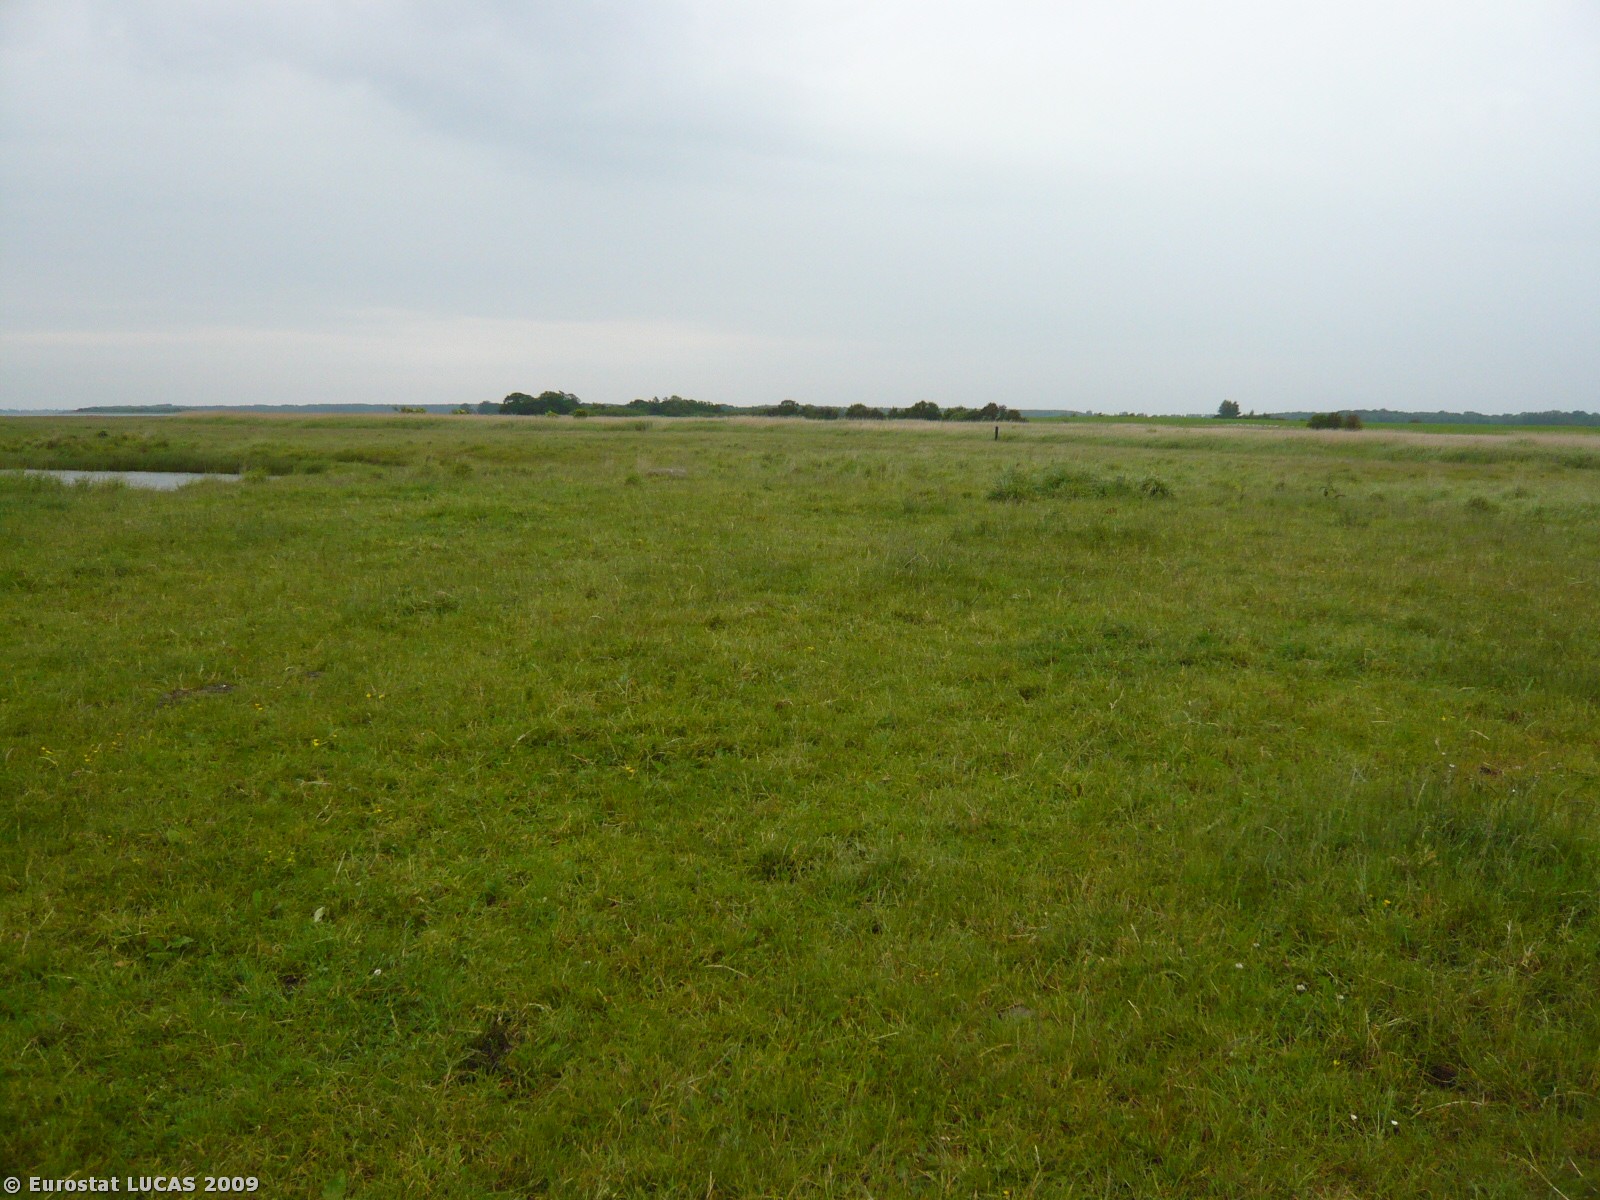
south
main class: Grassland
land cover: Grassland without tree/shrub cover
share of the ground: > 75 %
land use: Agriculture (excluding fallow land and kitchen gardens)
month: June
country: DK
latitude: 54.7366
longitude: 11.8160
